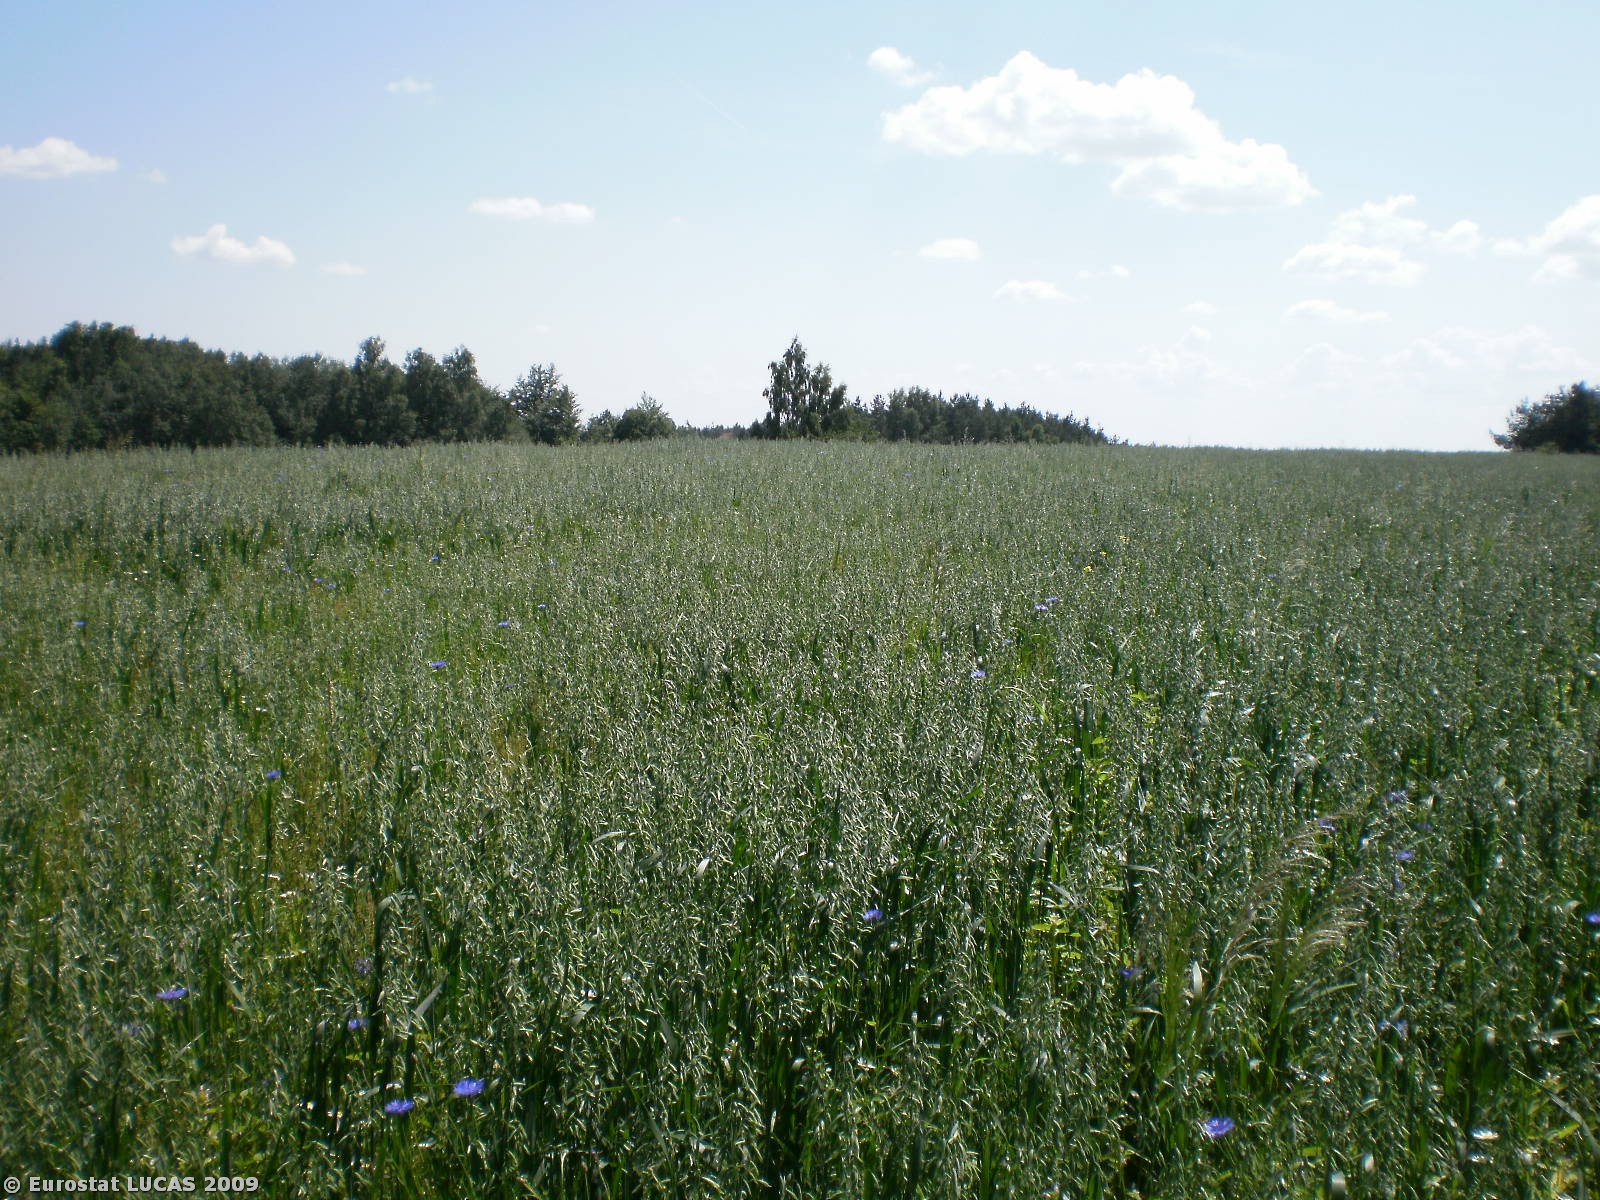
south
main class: Cropland
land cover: Oats
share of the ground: > 75 %
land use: Agriculture (excluding fallow land and kitchen gardens)
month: July
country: PL
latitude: 54.2803
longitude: 17.9232
